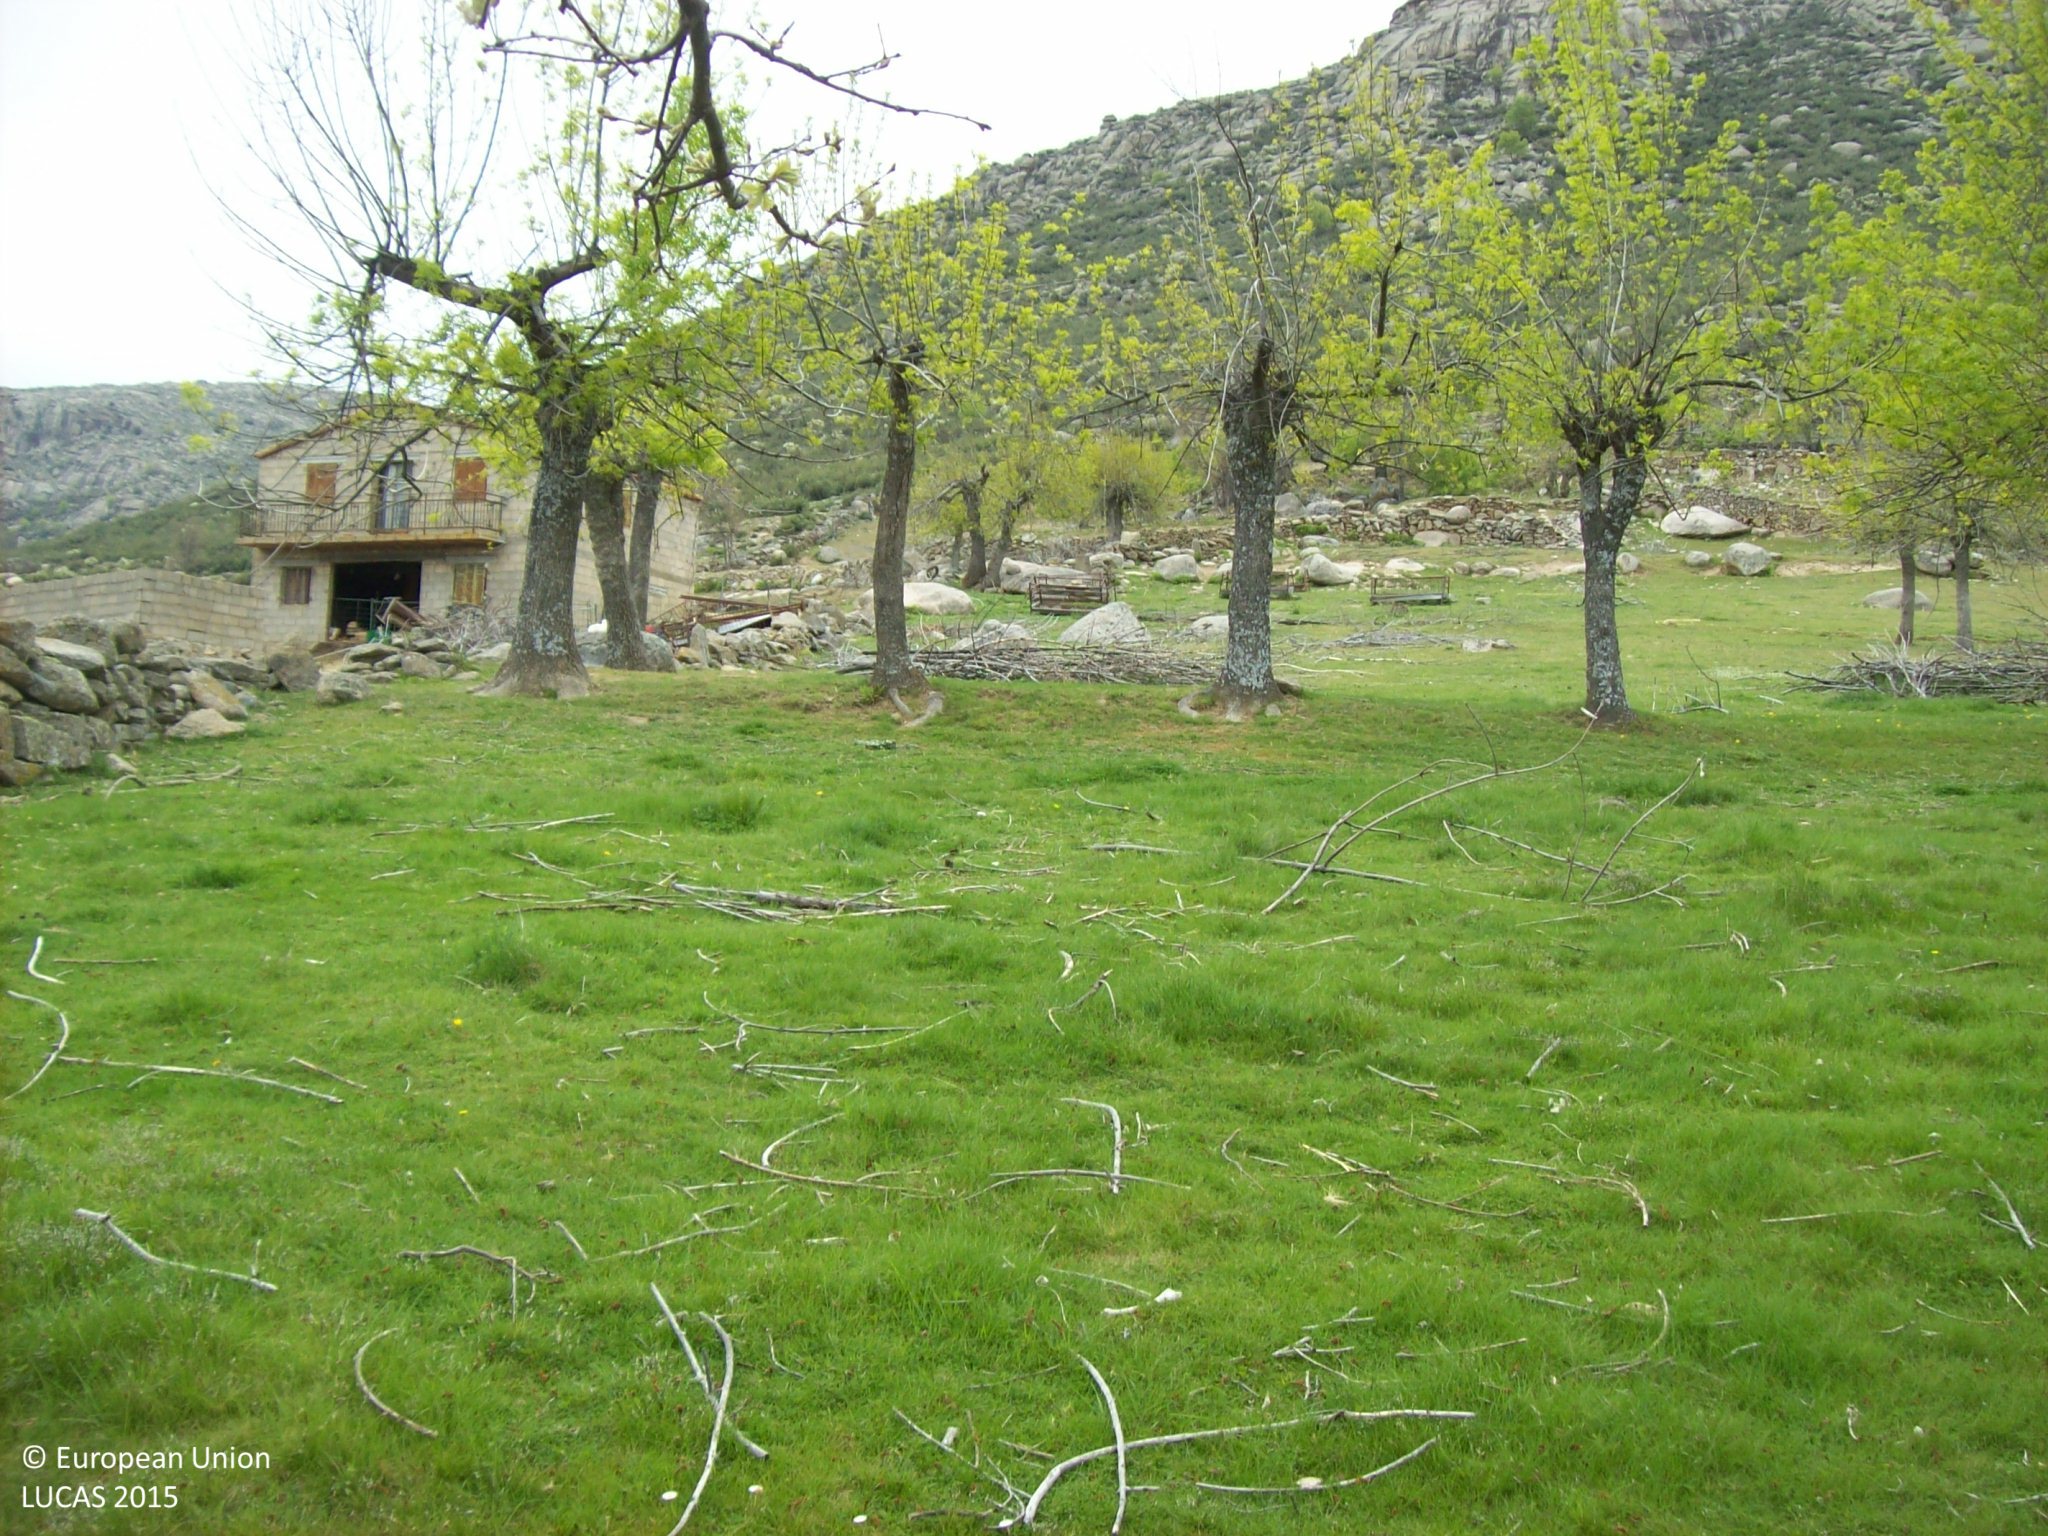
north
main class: Woodland
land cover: Broadleaved woodland
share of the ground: 10 - 25 %
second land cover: Grassland without tree/shrub cover
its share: > 75 %
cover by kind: herbaceous plants 75 %, broadleaved forest trees 25 %
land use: Forestry
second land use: Agriculture (excluding fallow land and kitchen gardens)
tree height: < 5 m
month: April
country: ES
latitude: 40.4089
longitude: -4.8911
